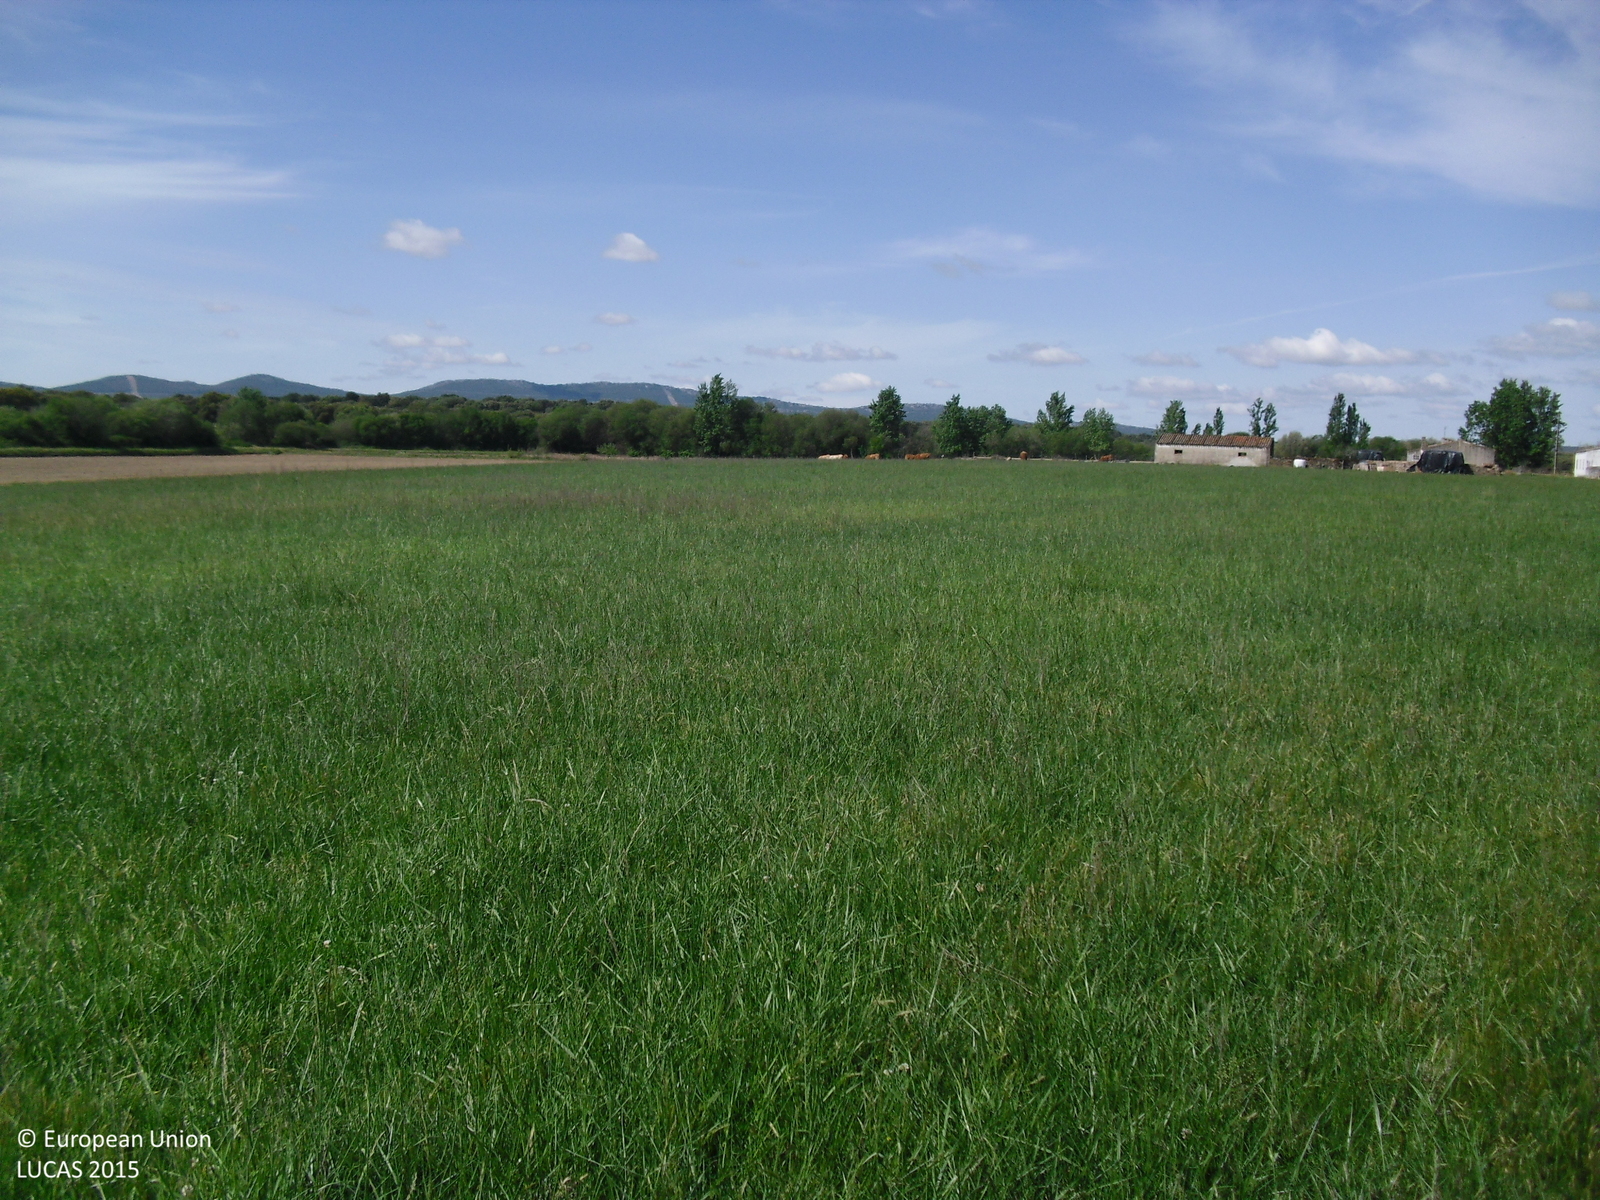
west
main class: Cropland
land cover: Temporary grasslands
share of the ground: > 75 %
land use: Agriculture (excluding fallow land and kitchen gardens)
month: April
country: ES
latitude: 40.0165
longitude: -6.7333
